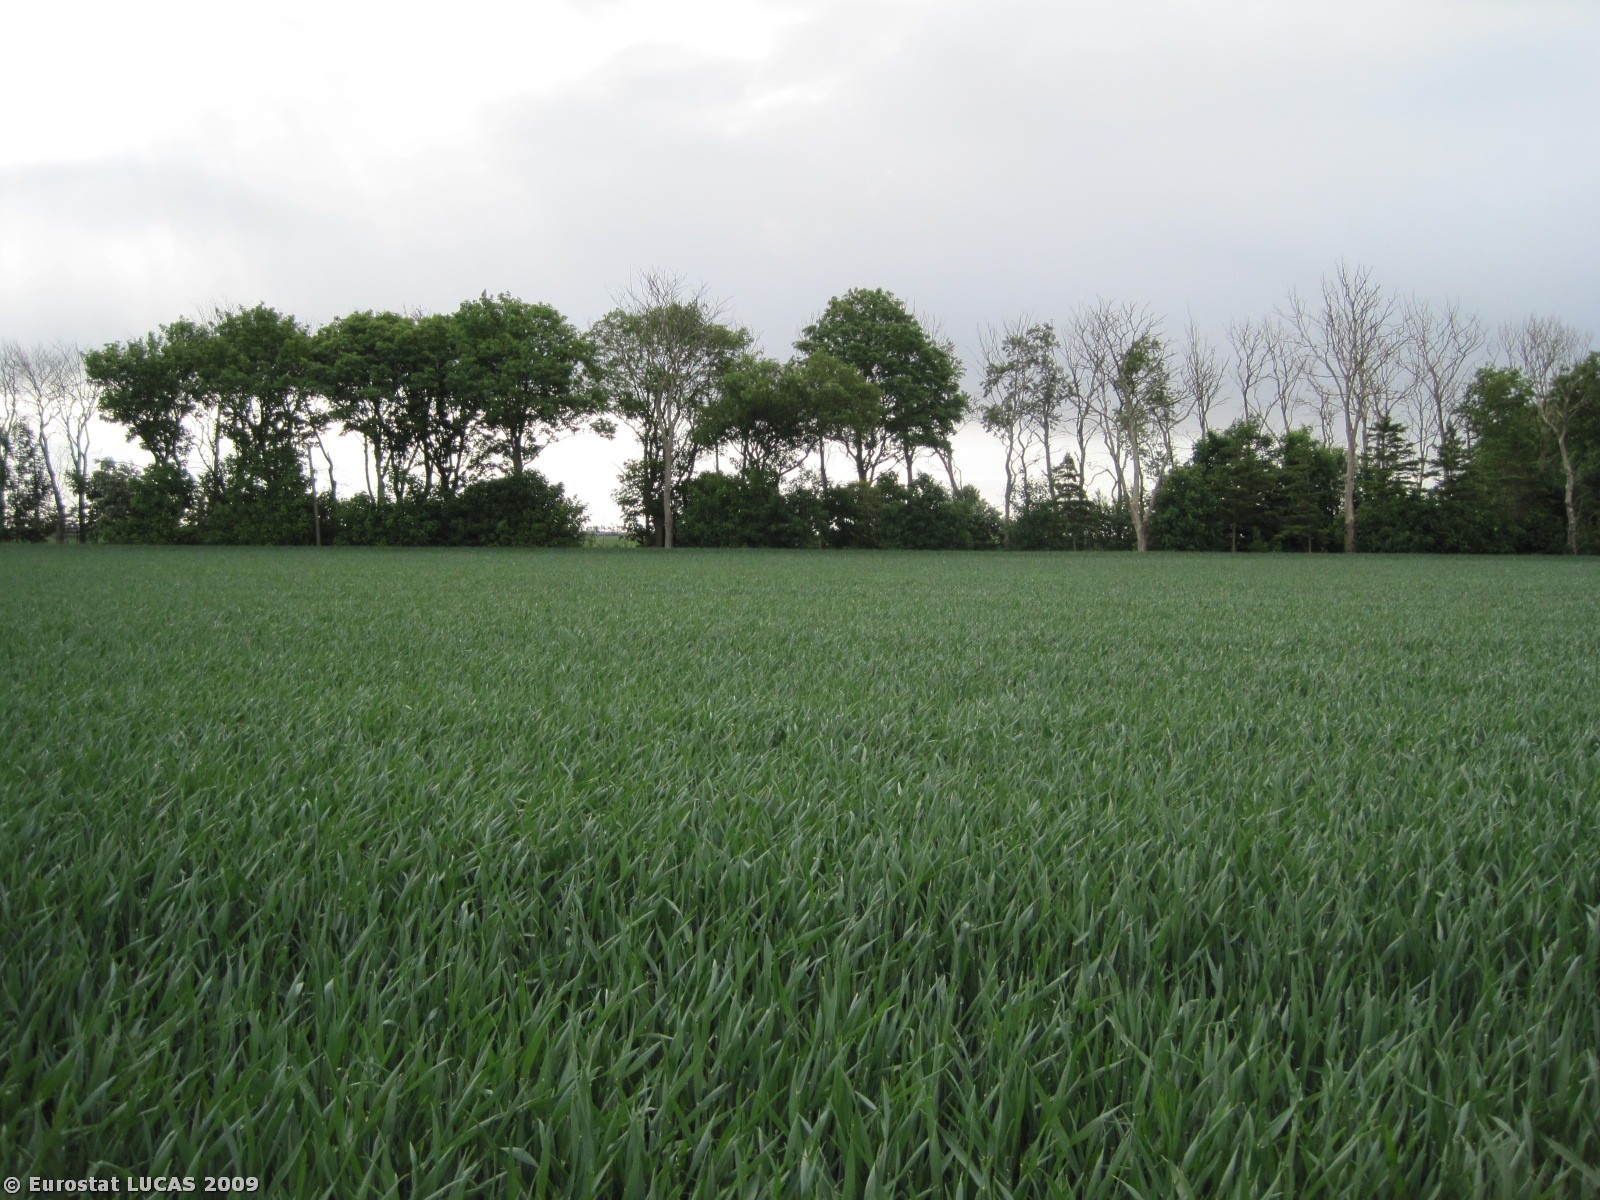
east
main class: Cropland
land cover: Common wheat
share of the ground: > 75 %
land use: Agriculture (excluding fallow land and kitchen gardens)
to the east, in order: Common wheat; Broadleaved woodland; Grass margins; Tracks; Grass margins; Broadleaved woodland; Common wheat
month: June
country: DK
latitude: 57.0326
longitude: 10.0823
